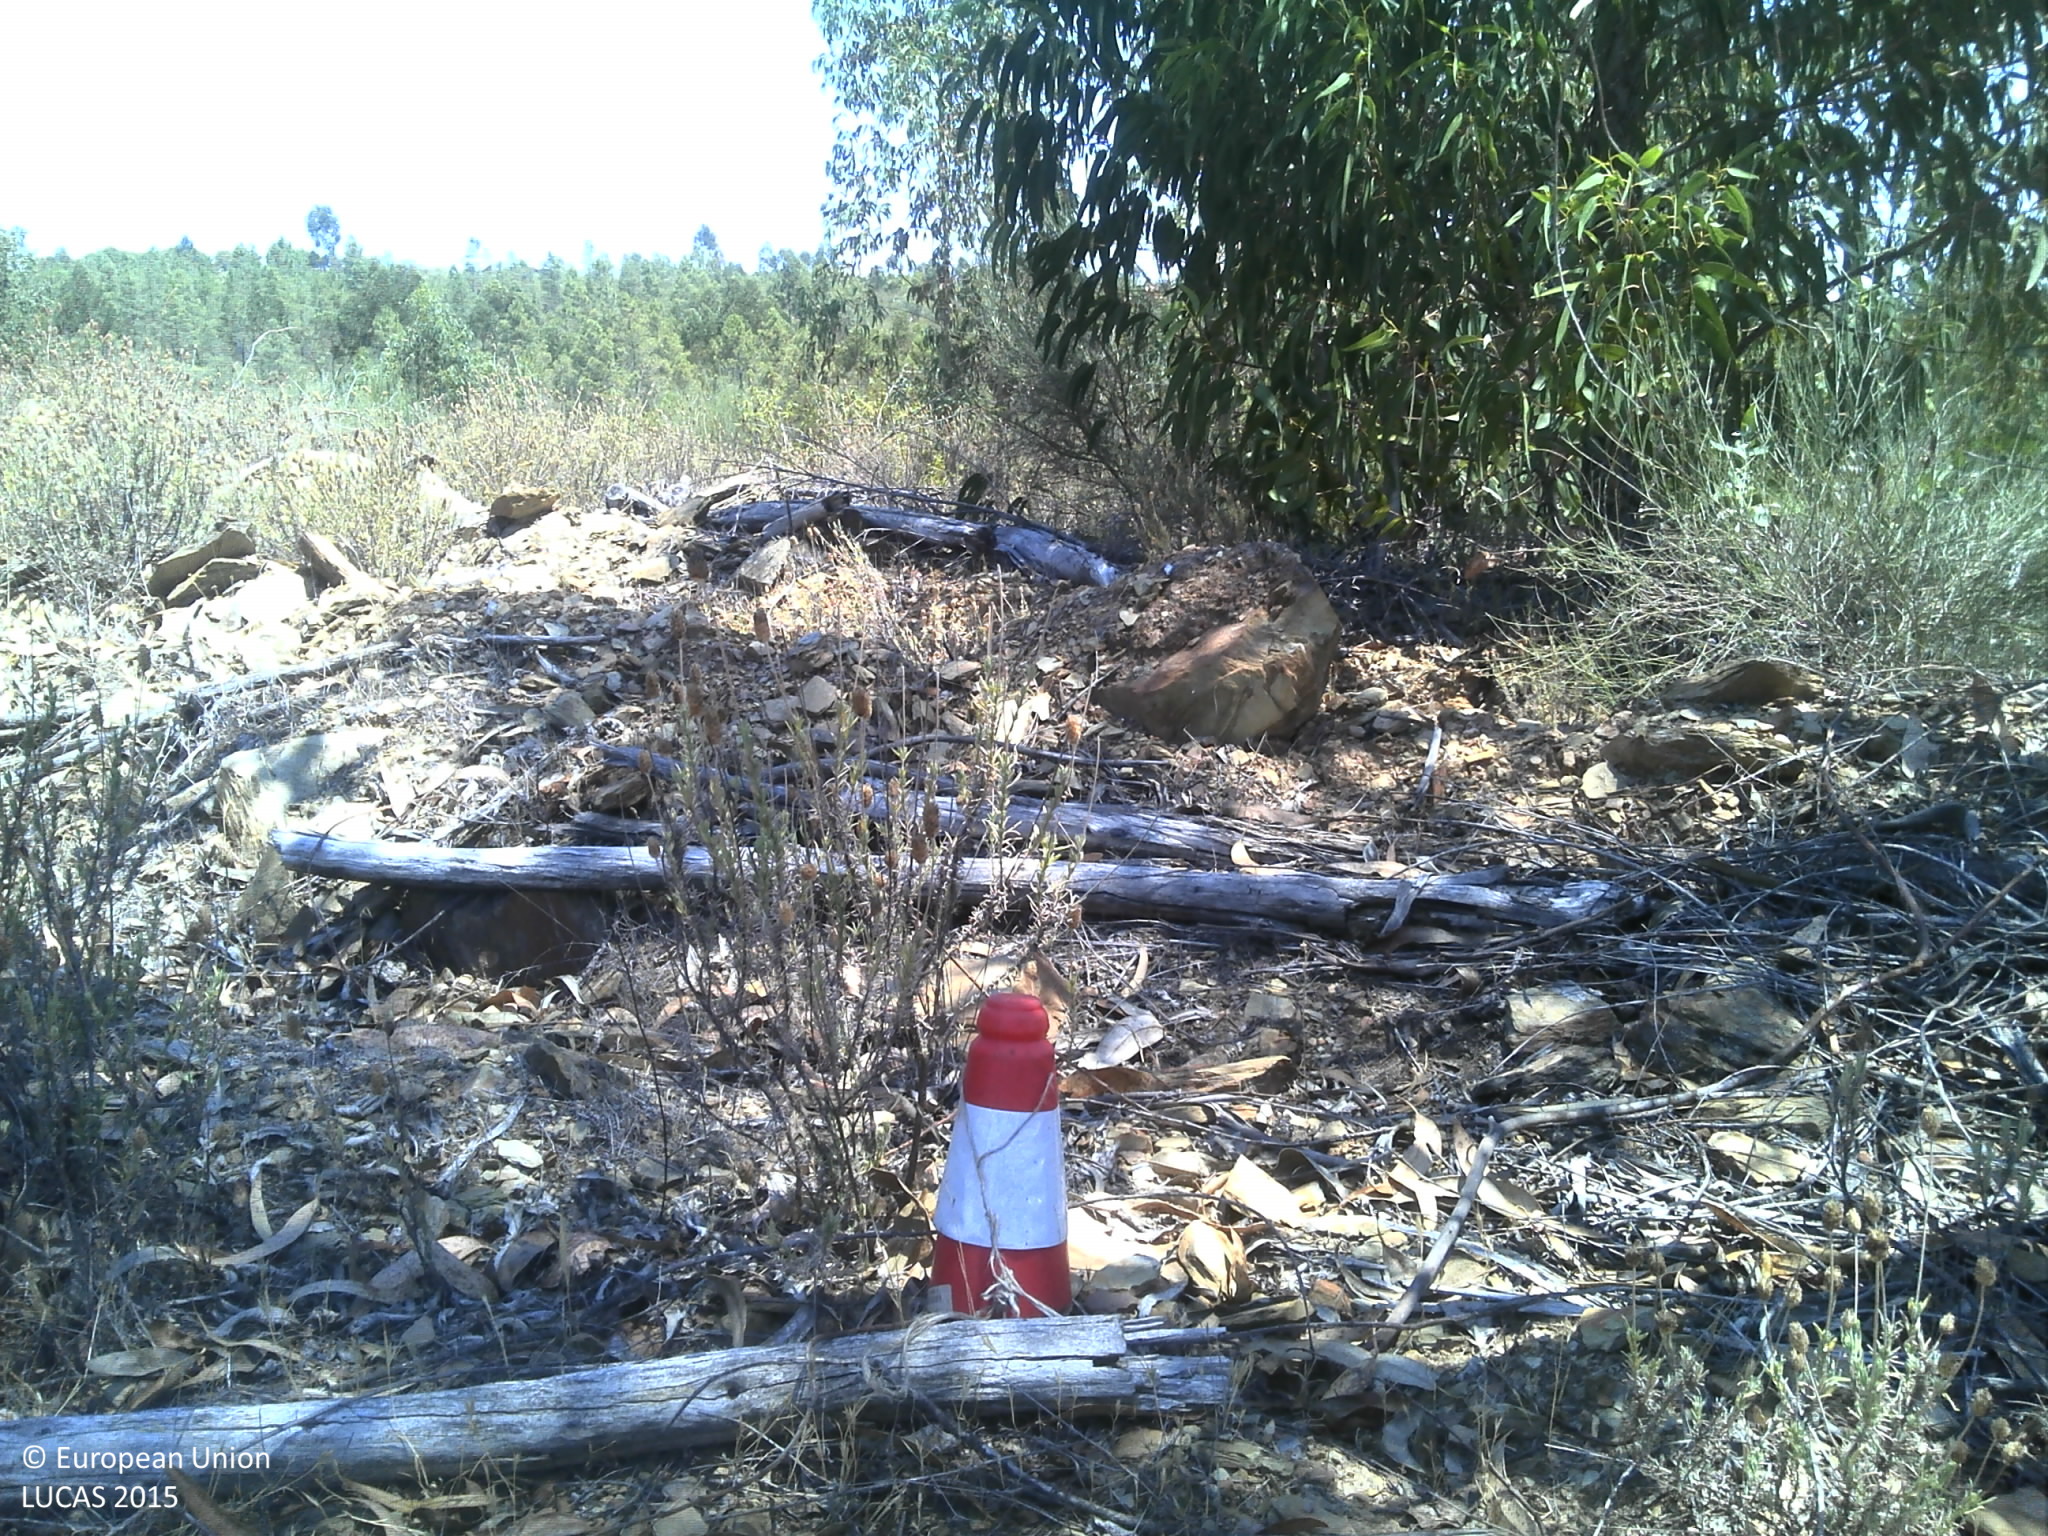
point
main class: Woodland
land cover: Broadleaved woodland
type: exotic forest
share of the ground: 25 - 50 %
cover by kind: broadleaved forest trees 50 %, unconsolidated bare surface 35 %, shrubs 15 %
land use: Forestry
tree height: > 5 m
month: June
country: PT
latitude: 39.7669
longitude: -7.0017
